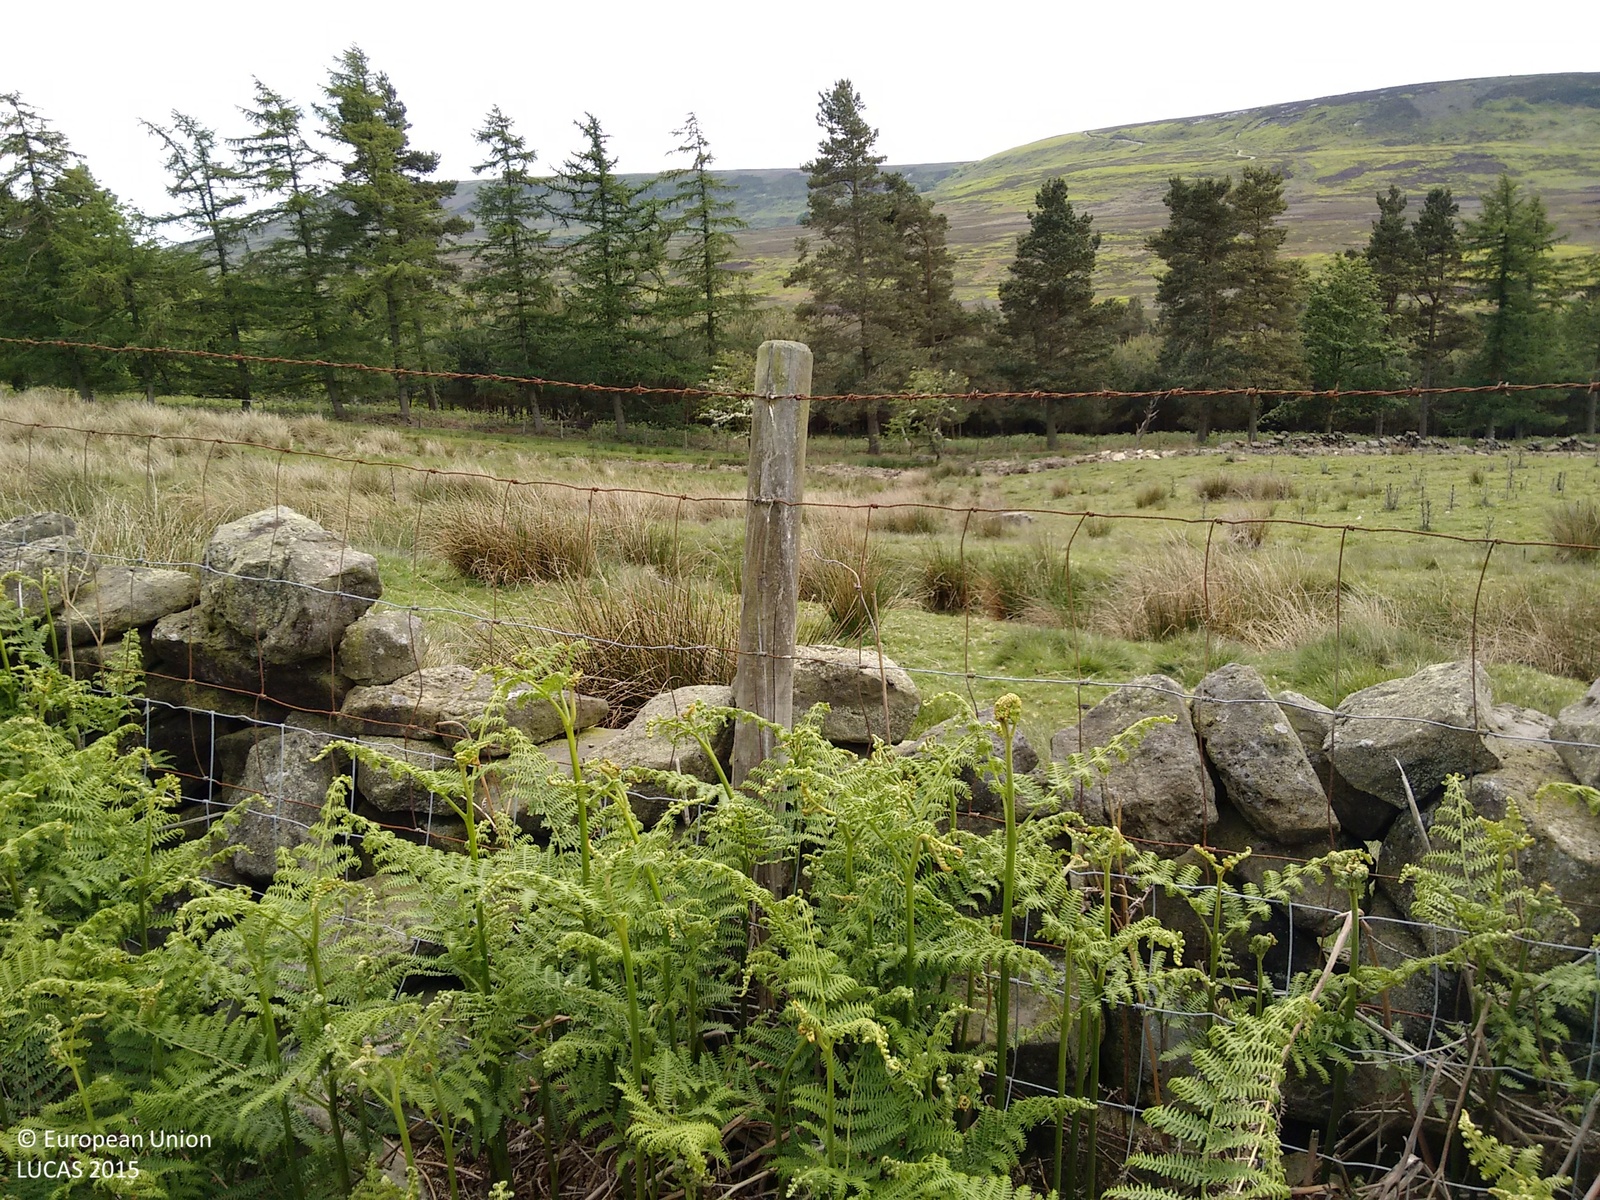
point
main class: Grassland
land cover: Grassland without tree/shrub cover
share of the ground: > 75 %
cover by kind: herbaceous plants 100 %
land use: Agriculture (excluding fallow land and kitchen gardens)
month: June
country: GB
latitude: 54.3488
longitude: -1.2297
